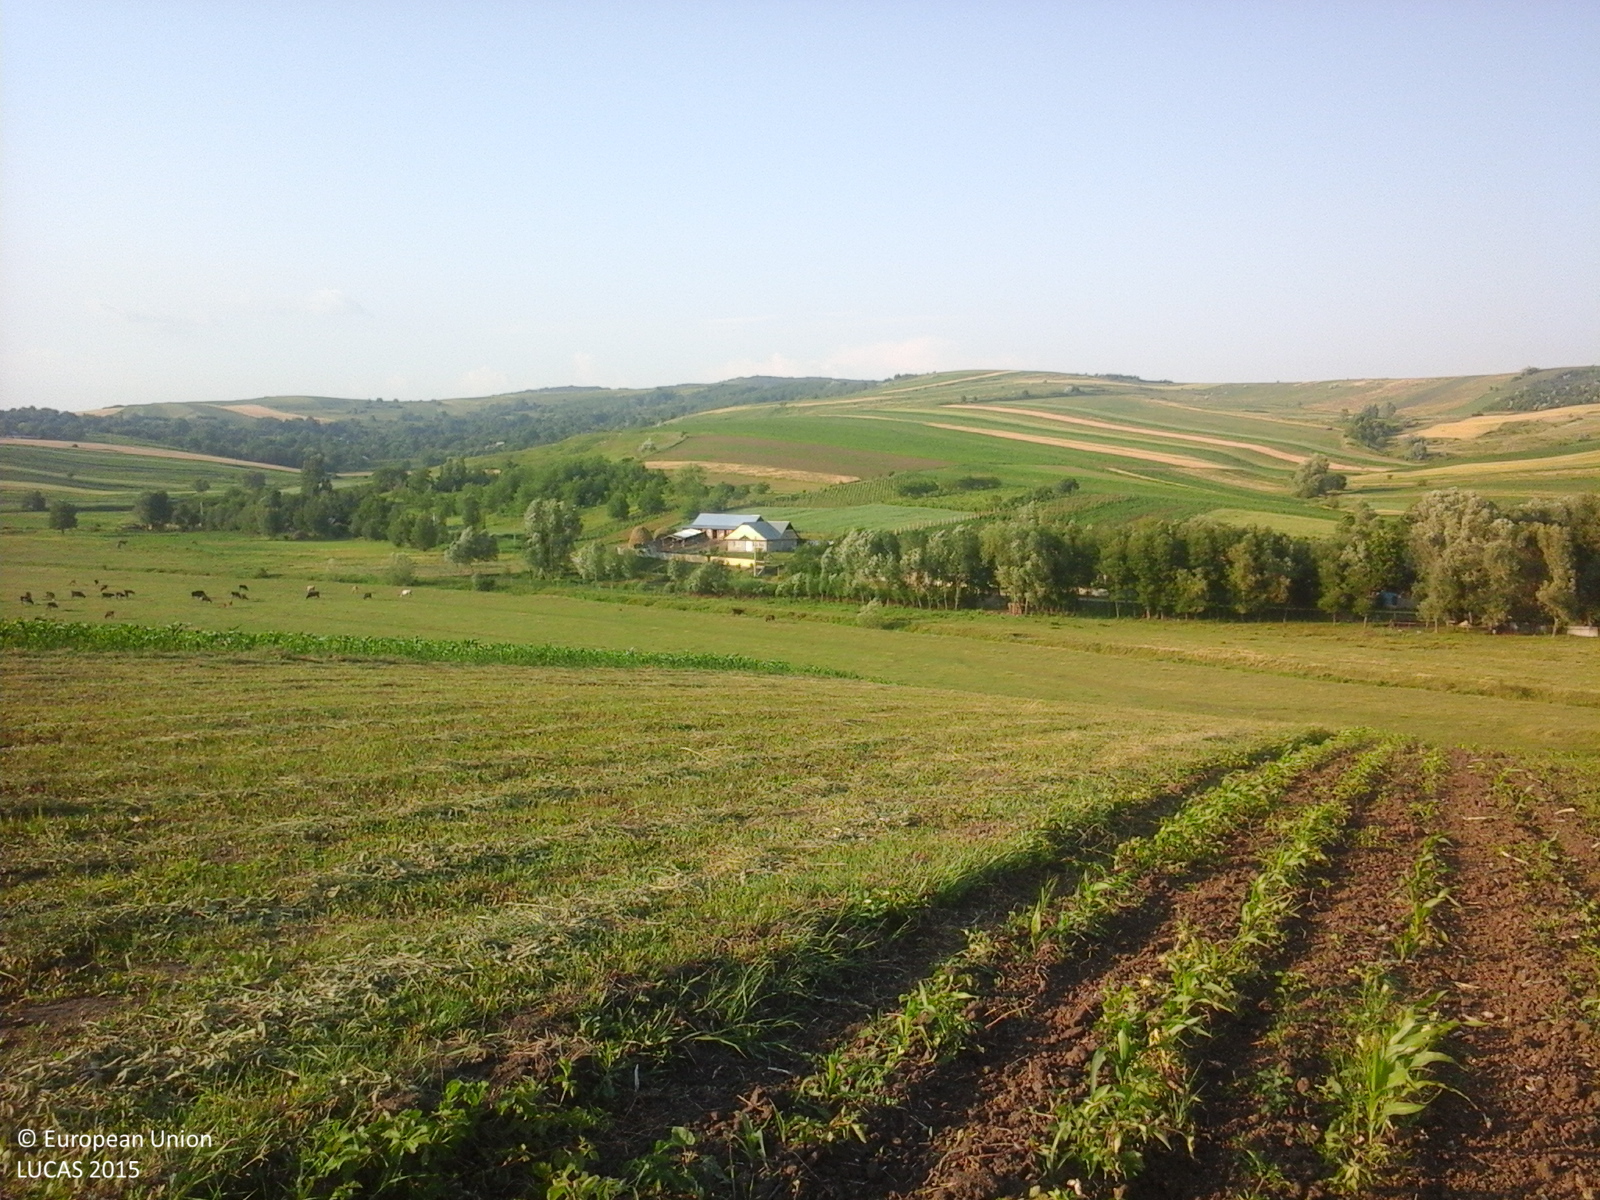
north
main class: Cropland
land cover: Maize
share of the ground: 10 - 25 %
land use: Agriculture (excluding fallow land and kitchen gardens)
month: June
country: RO
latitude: 46.6990
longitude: 27.3848
